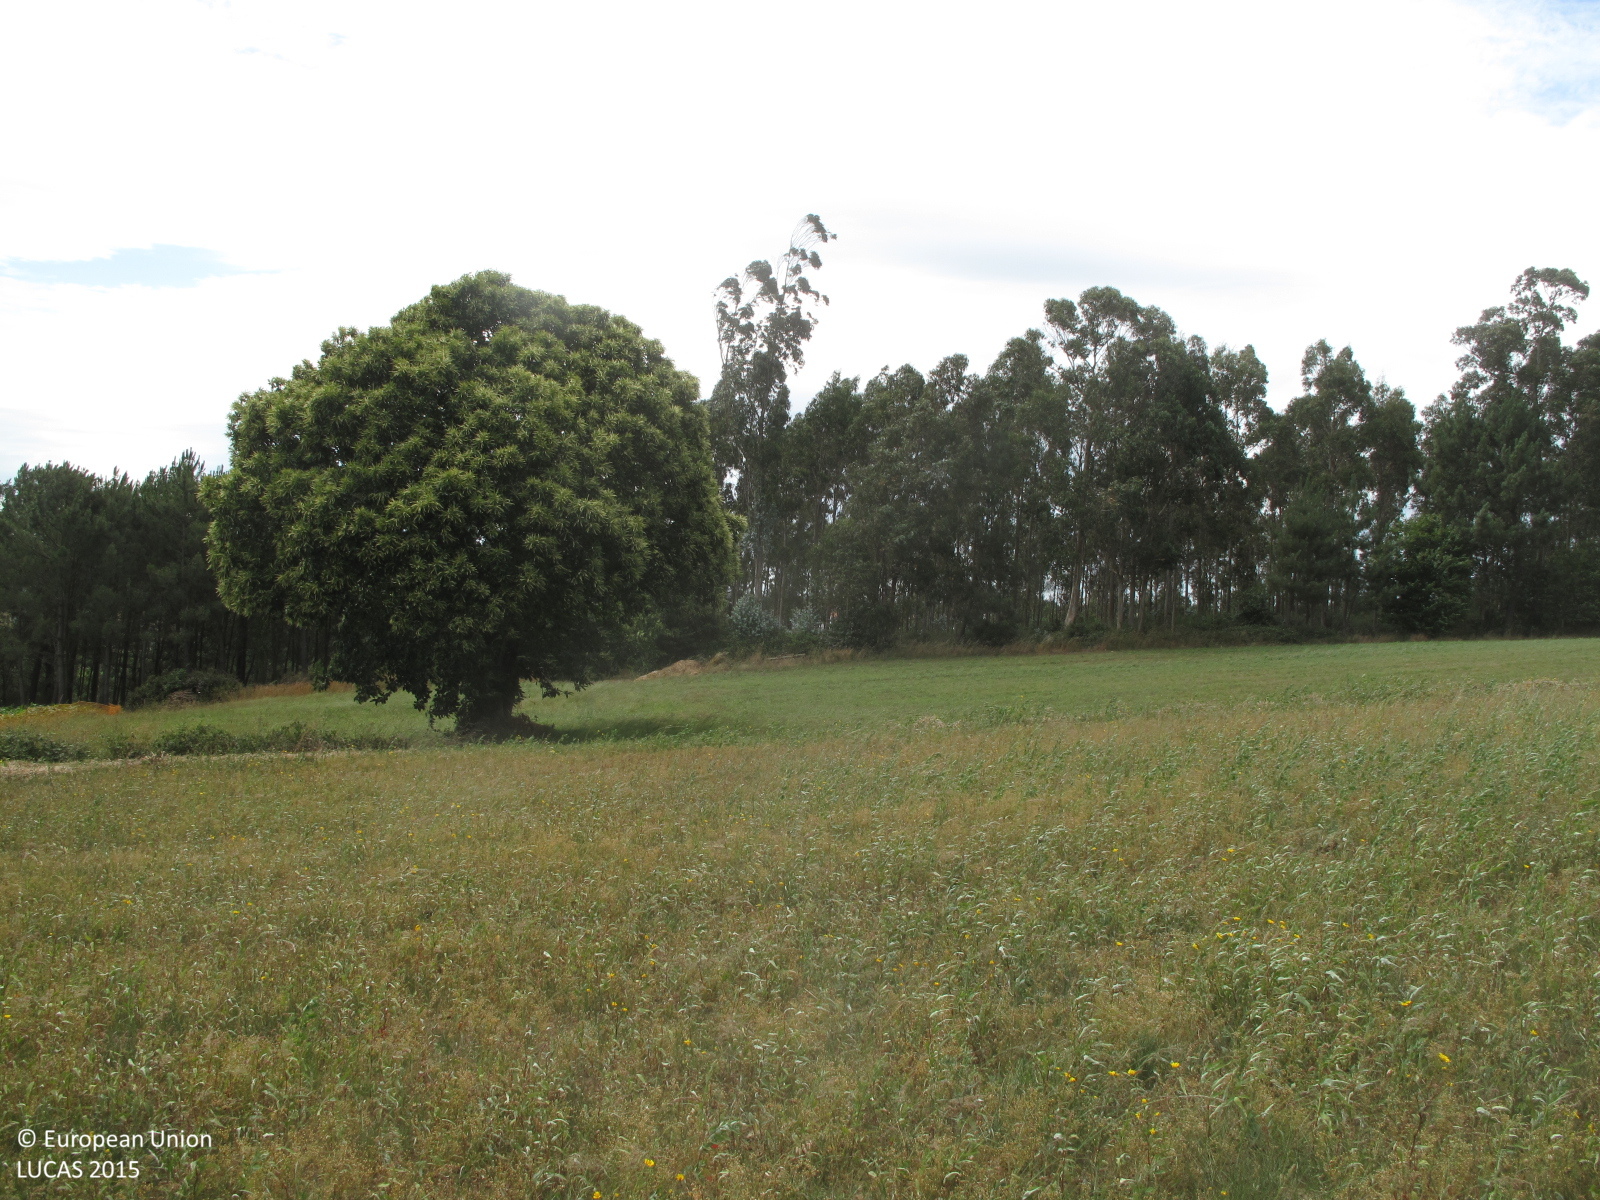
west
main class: Grassland
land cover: Spontaneously vegetated surfaces
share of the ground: 50 - 75 %
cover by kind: herbaceous plants 70 %, unconsolidated bare surface 30 %
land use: Fallow land
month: July
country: ES
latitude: 43.2160
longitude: -8.6387
